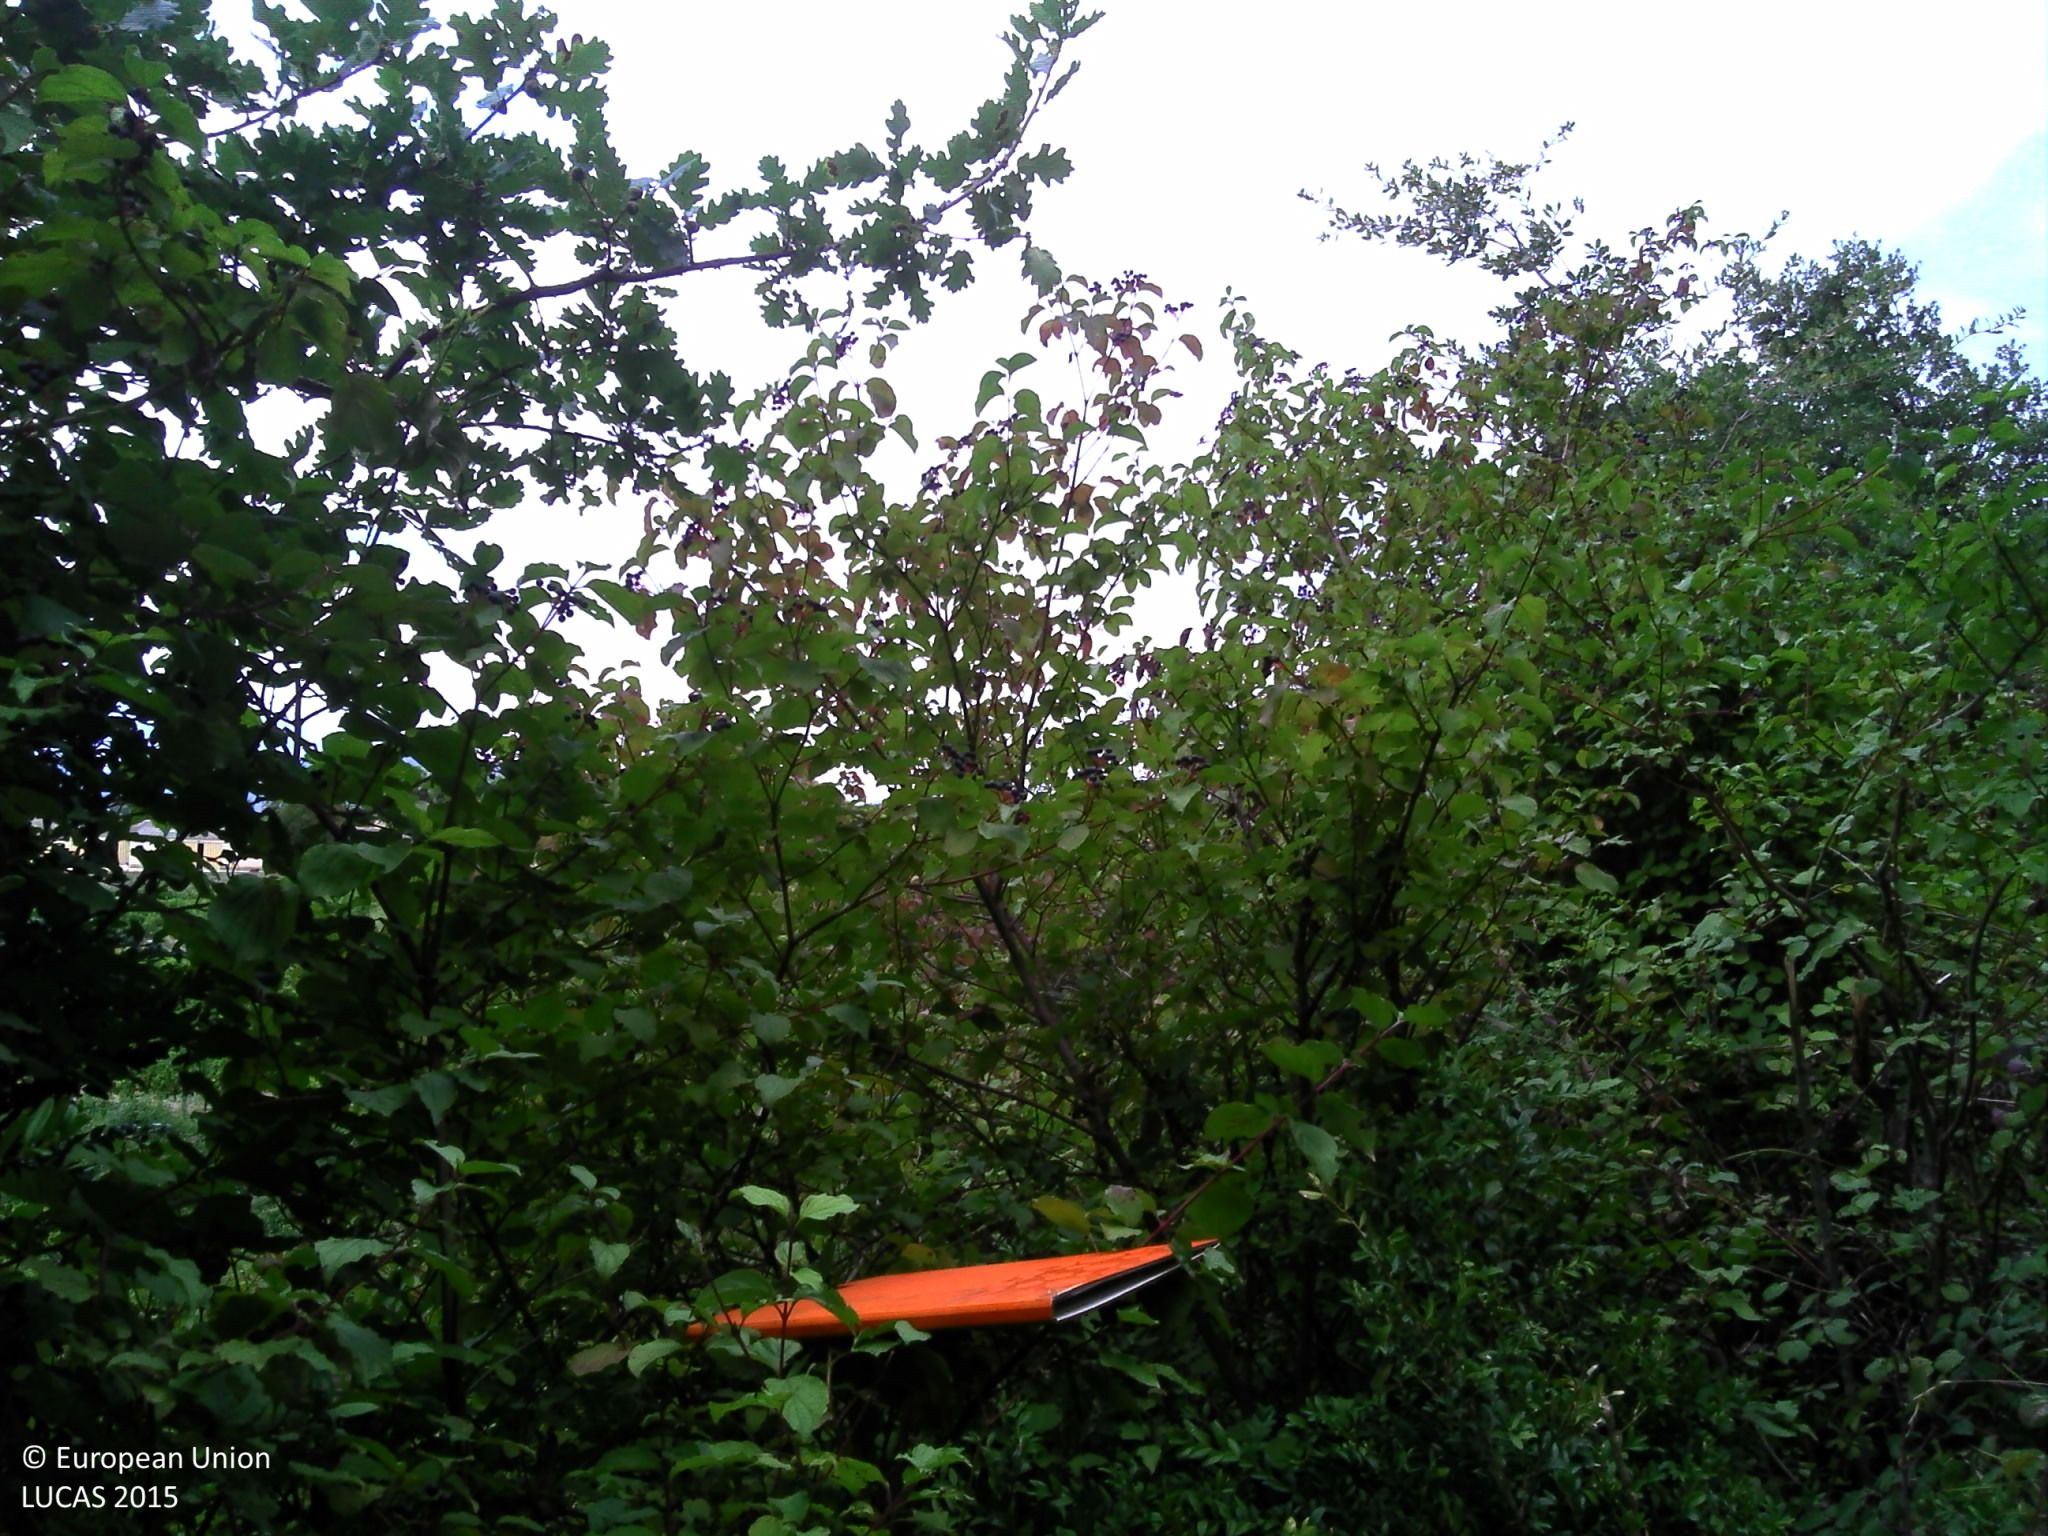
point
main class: Woodland
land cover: Broadleaved woodland
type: thermophilous deciduous forest
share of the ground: > 75 %
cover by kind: broadleaved forest trees 90 %, coniferous forest trees 5 %, herbaceous plants 5 %
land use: Forestry
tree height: > 5 m
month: September
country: FR
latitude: 44.3062
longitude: 5.0811
